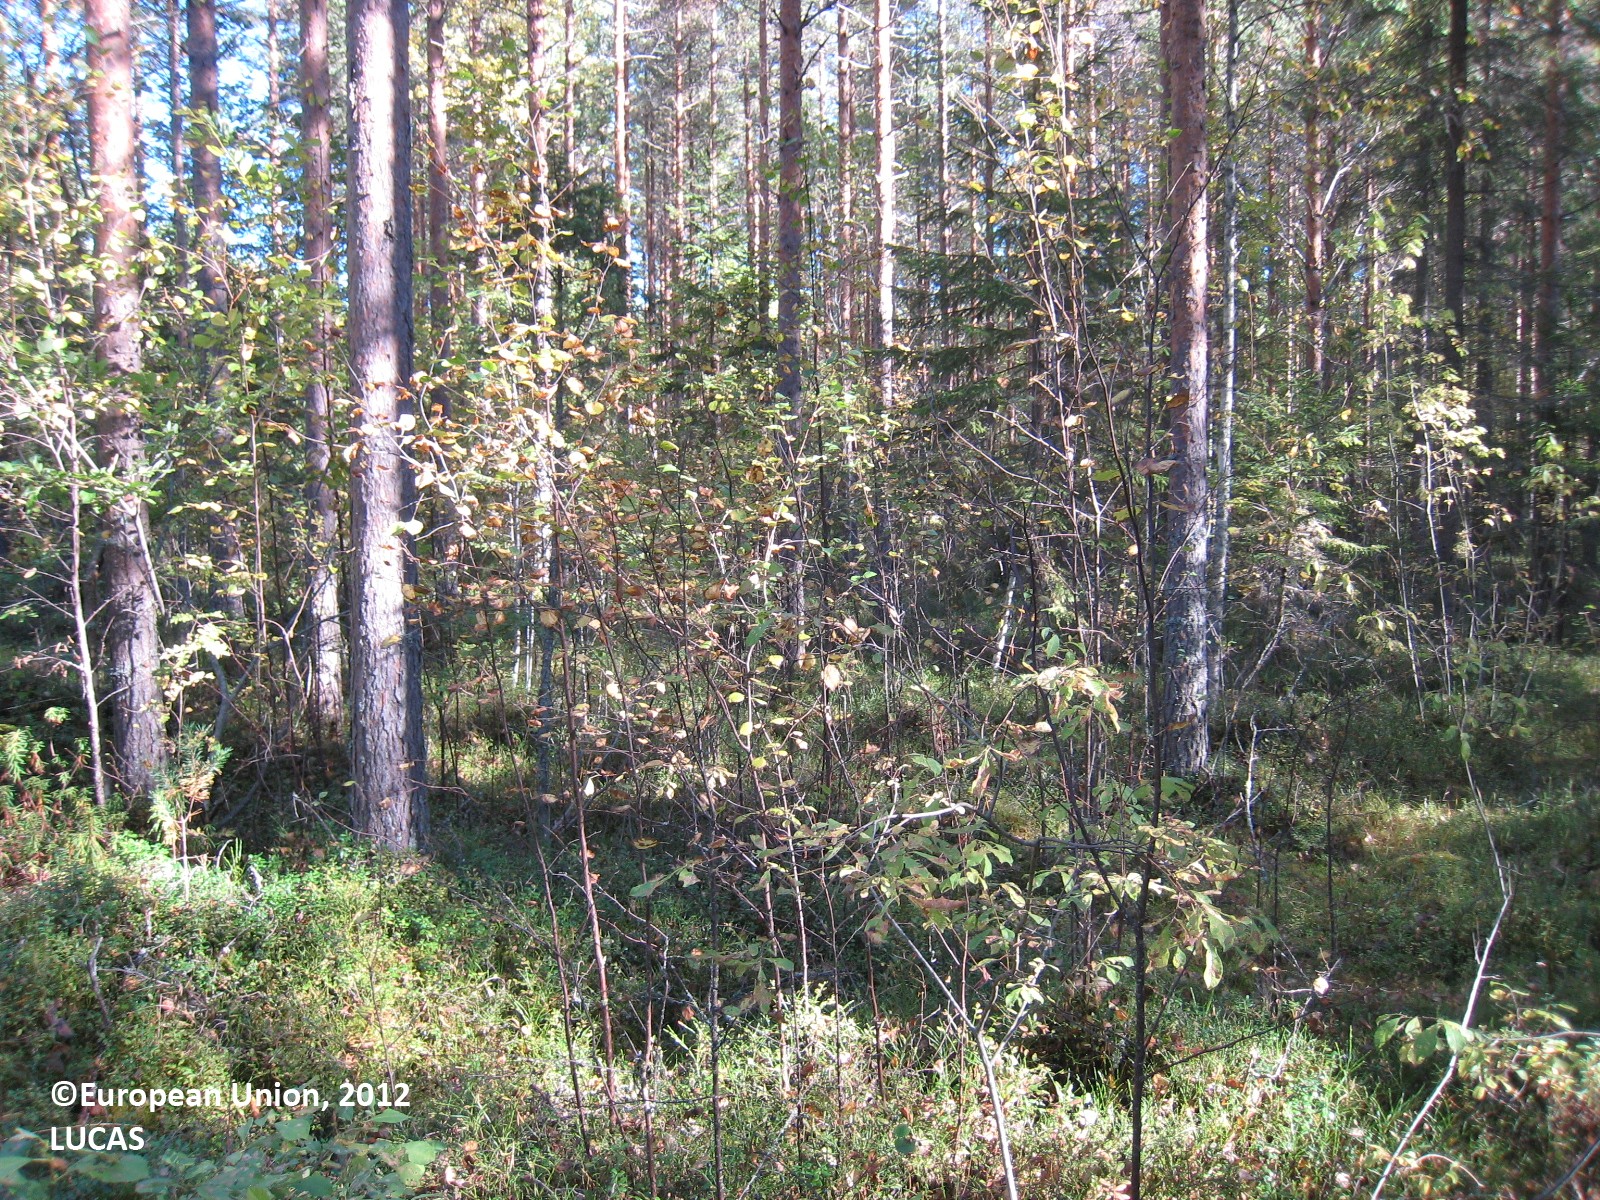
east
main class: Woodland
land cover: Pine dominated mixed woodland
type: boreal forest
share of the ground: > 75 %
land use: Forestry
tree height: > 5 m
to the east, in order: Pine dominated mixed woodland; Pine dominated coniferous woodland; Grassland without tree/shrub cover; Ditches and canals; Grass margins; Paved roads, cycling and walking lanes; Shruby margins; Ditches and canals; Pine dominated coniferous woodland
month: September
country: FI
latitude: 62.8453
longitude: 26.6149
